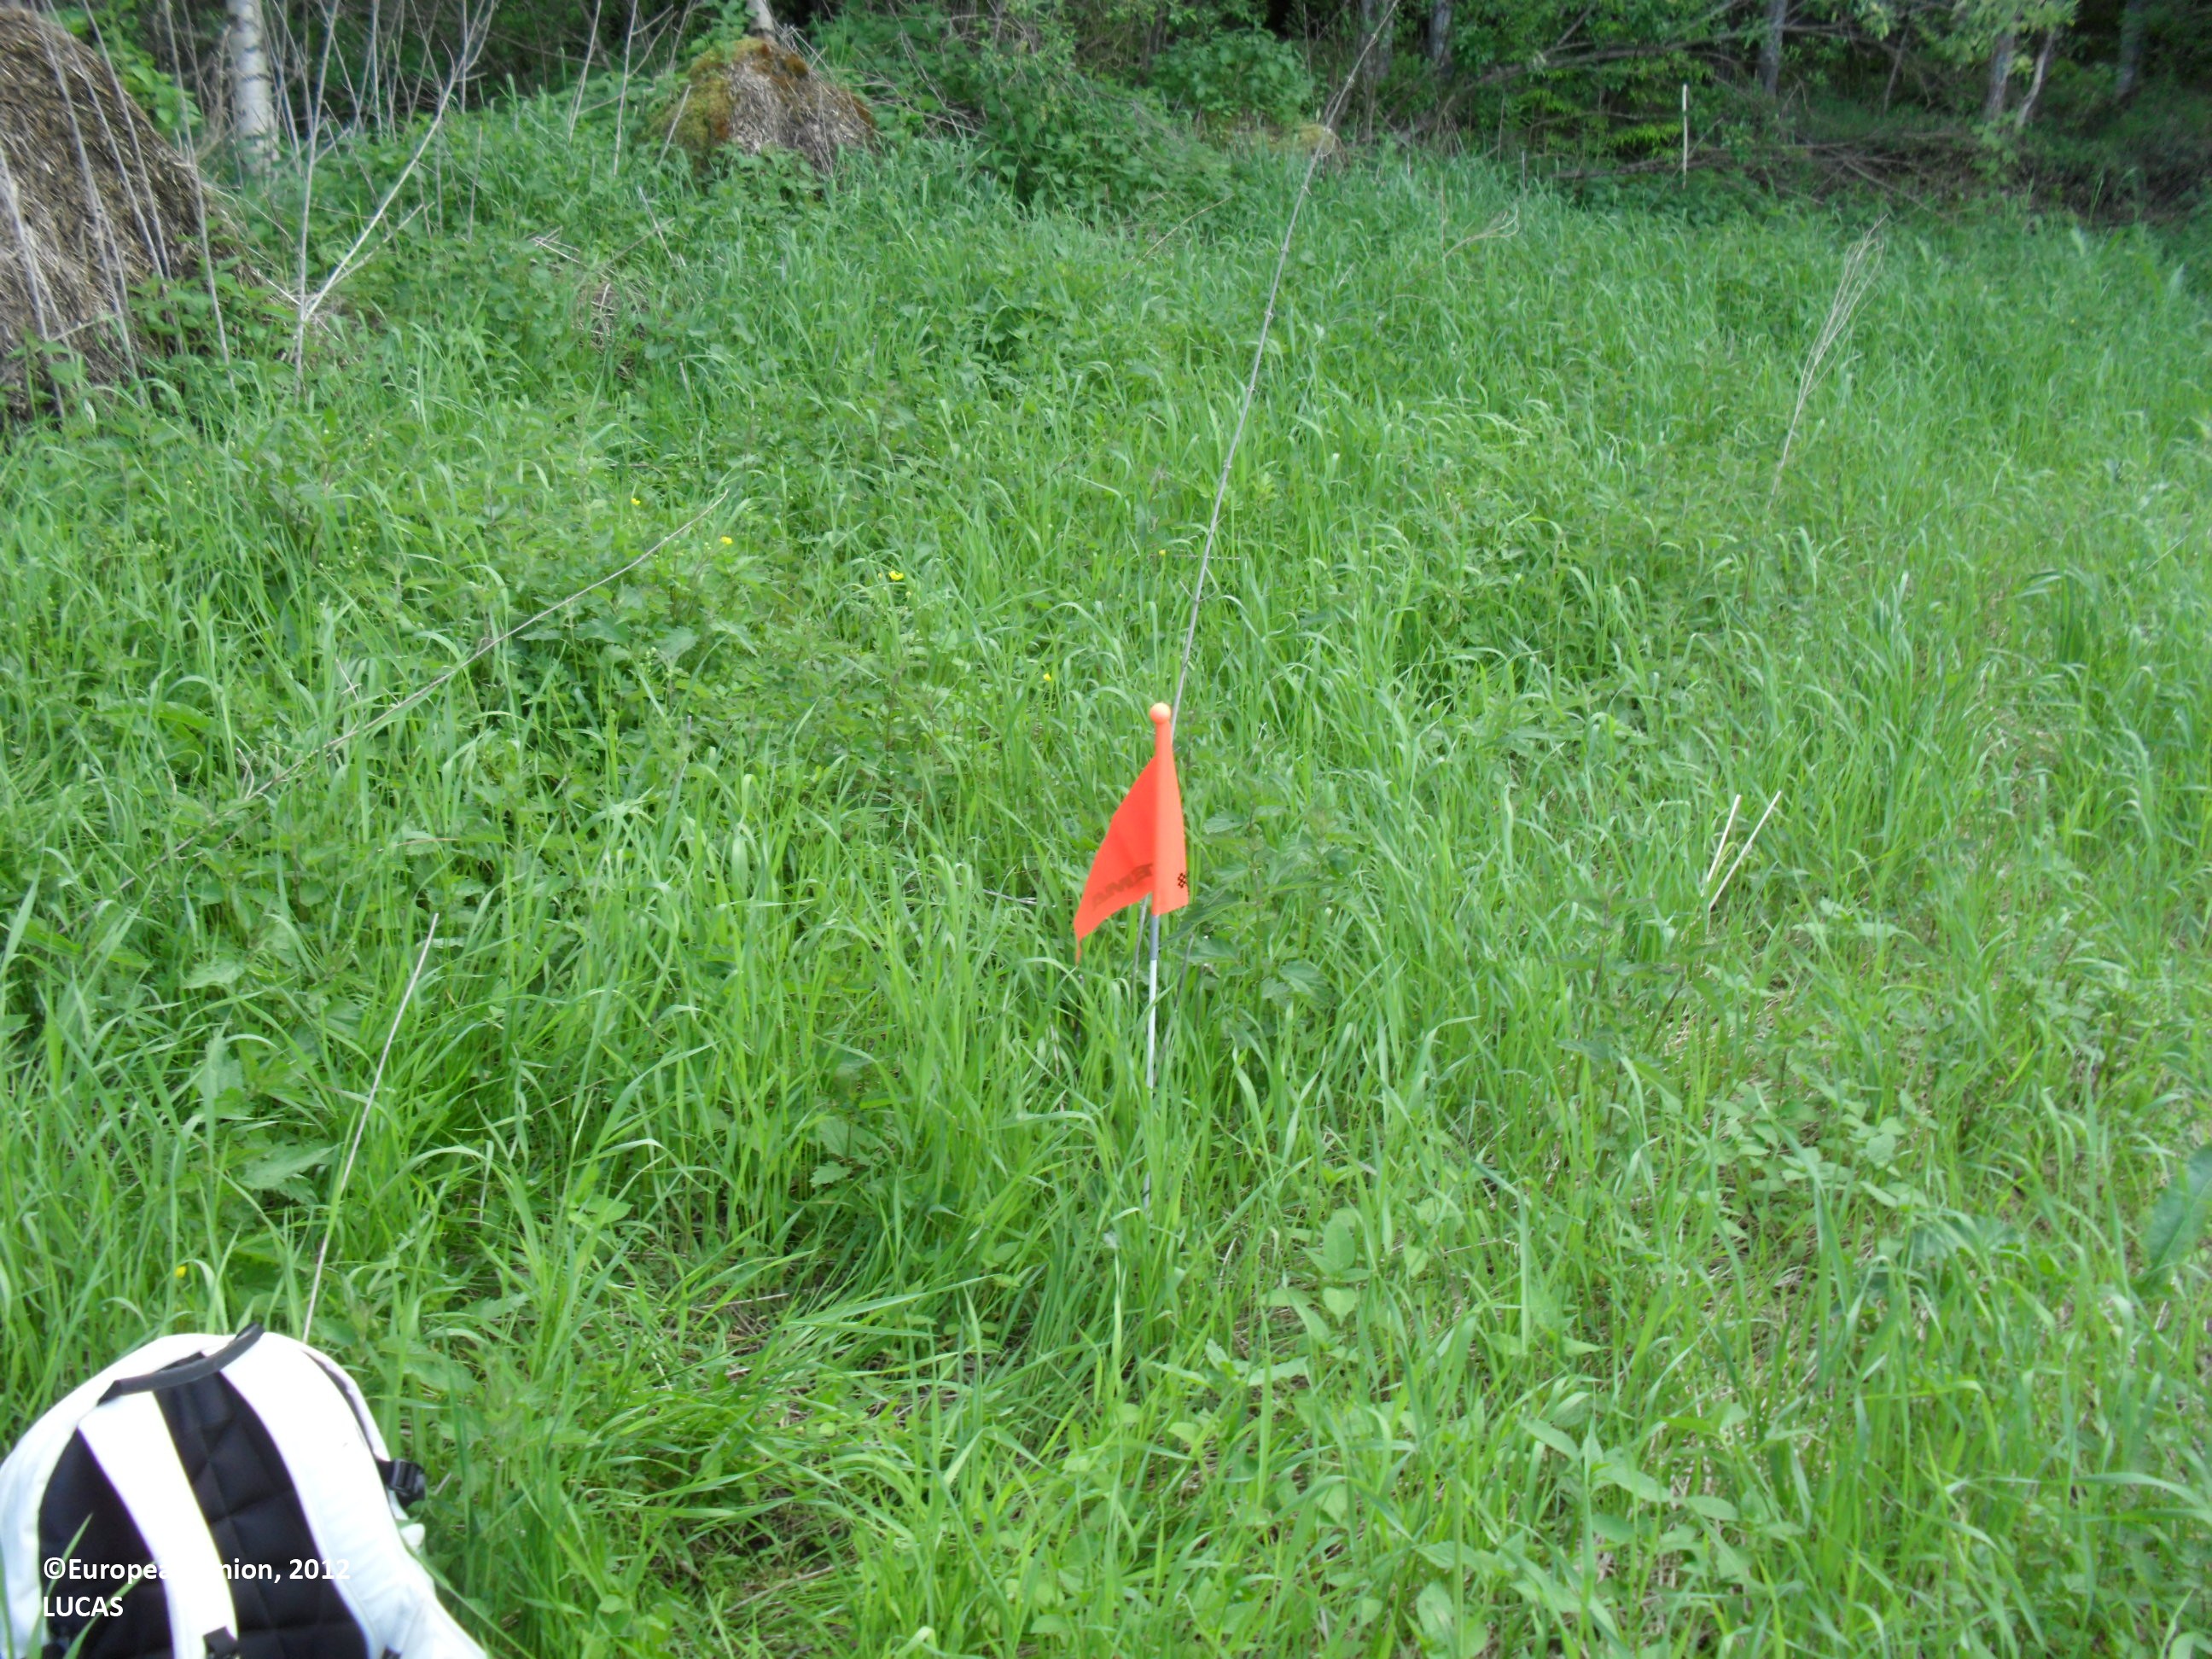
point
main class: Grassland
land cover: Grassland without tree/shrub cover
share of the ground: > 75 %
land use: Agriculture (excluding fallow land and kitchen gardens)
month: June
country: FI
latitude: 62.8218
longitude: 23.5509
